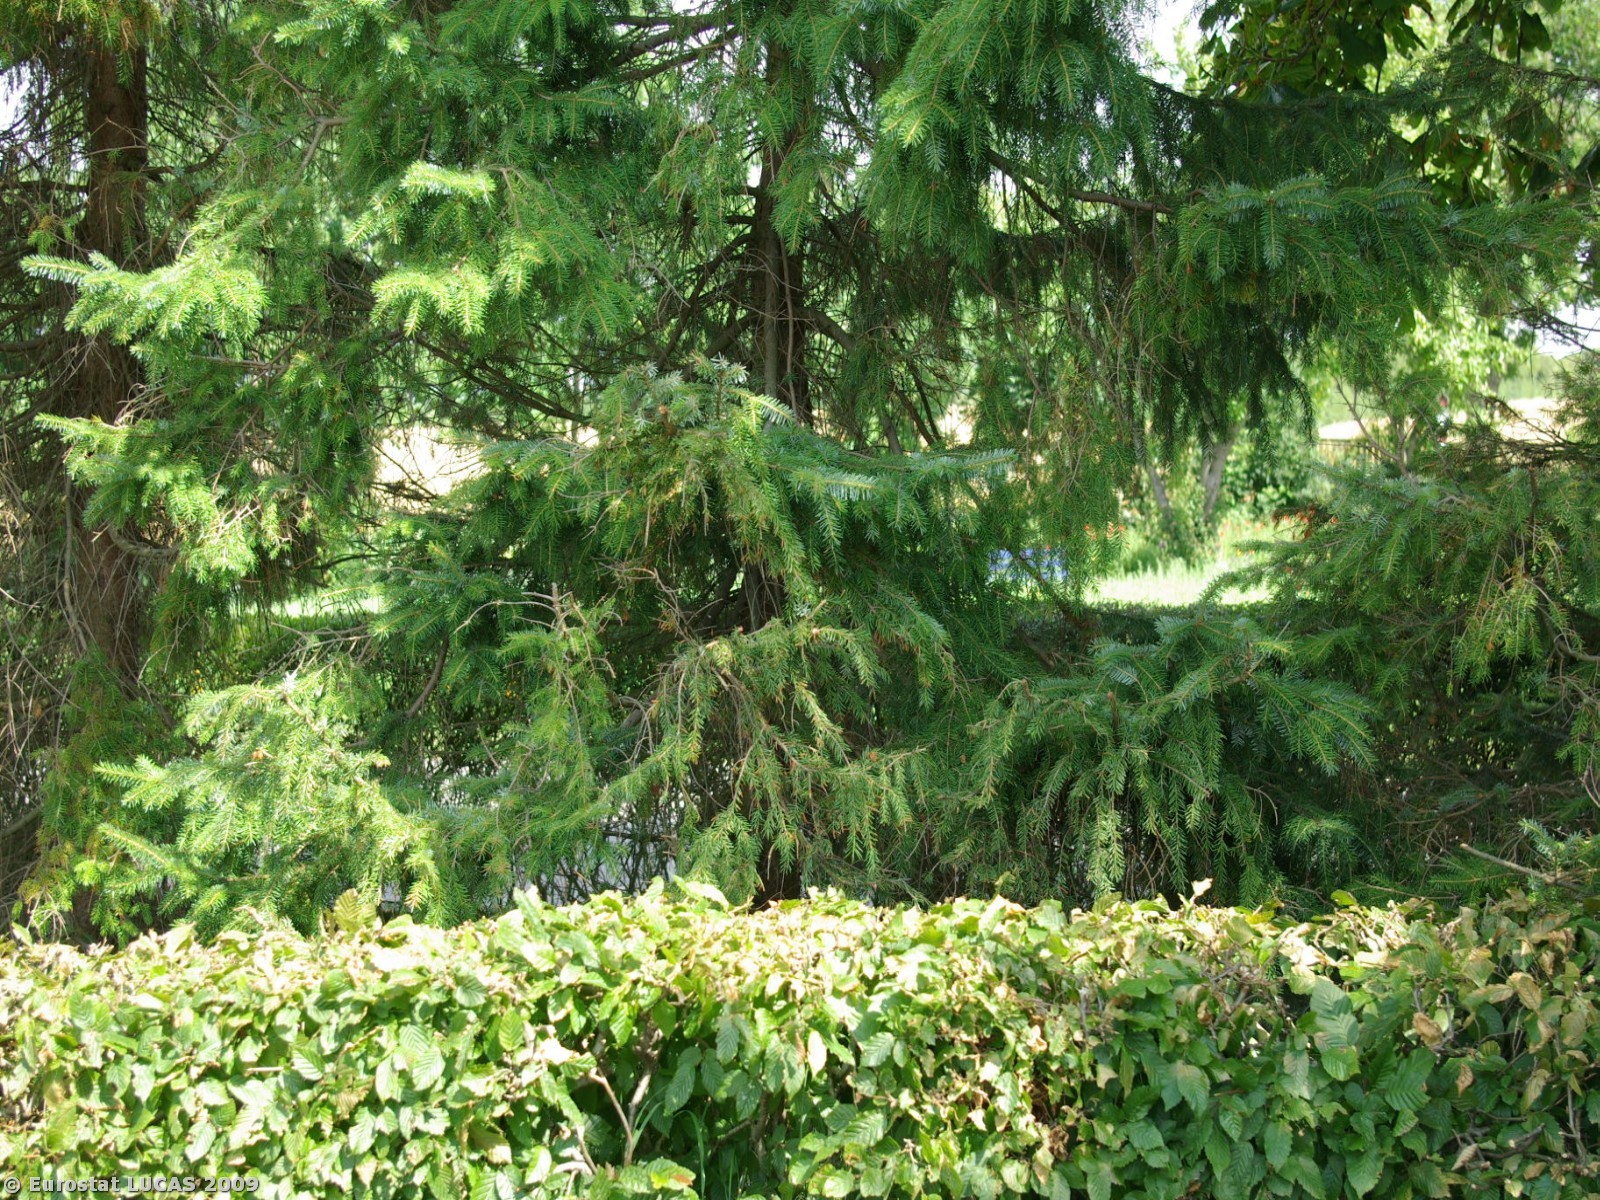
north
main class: Cropland
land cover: Common wheat
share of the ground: > 75 %
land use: Agriculture (excluding fallow land and kitchen gardens)
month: July
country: DK
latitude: 54.8756
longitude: 9.9221
